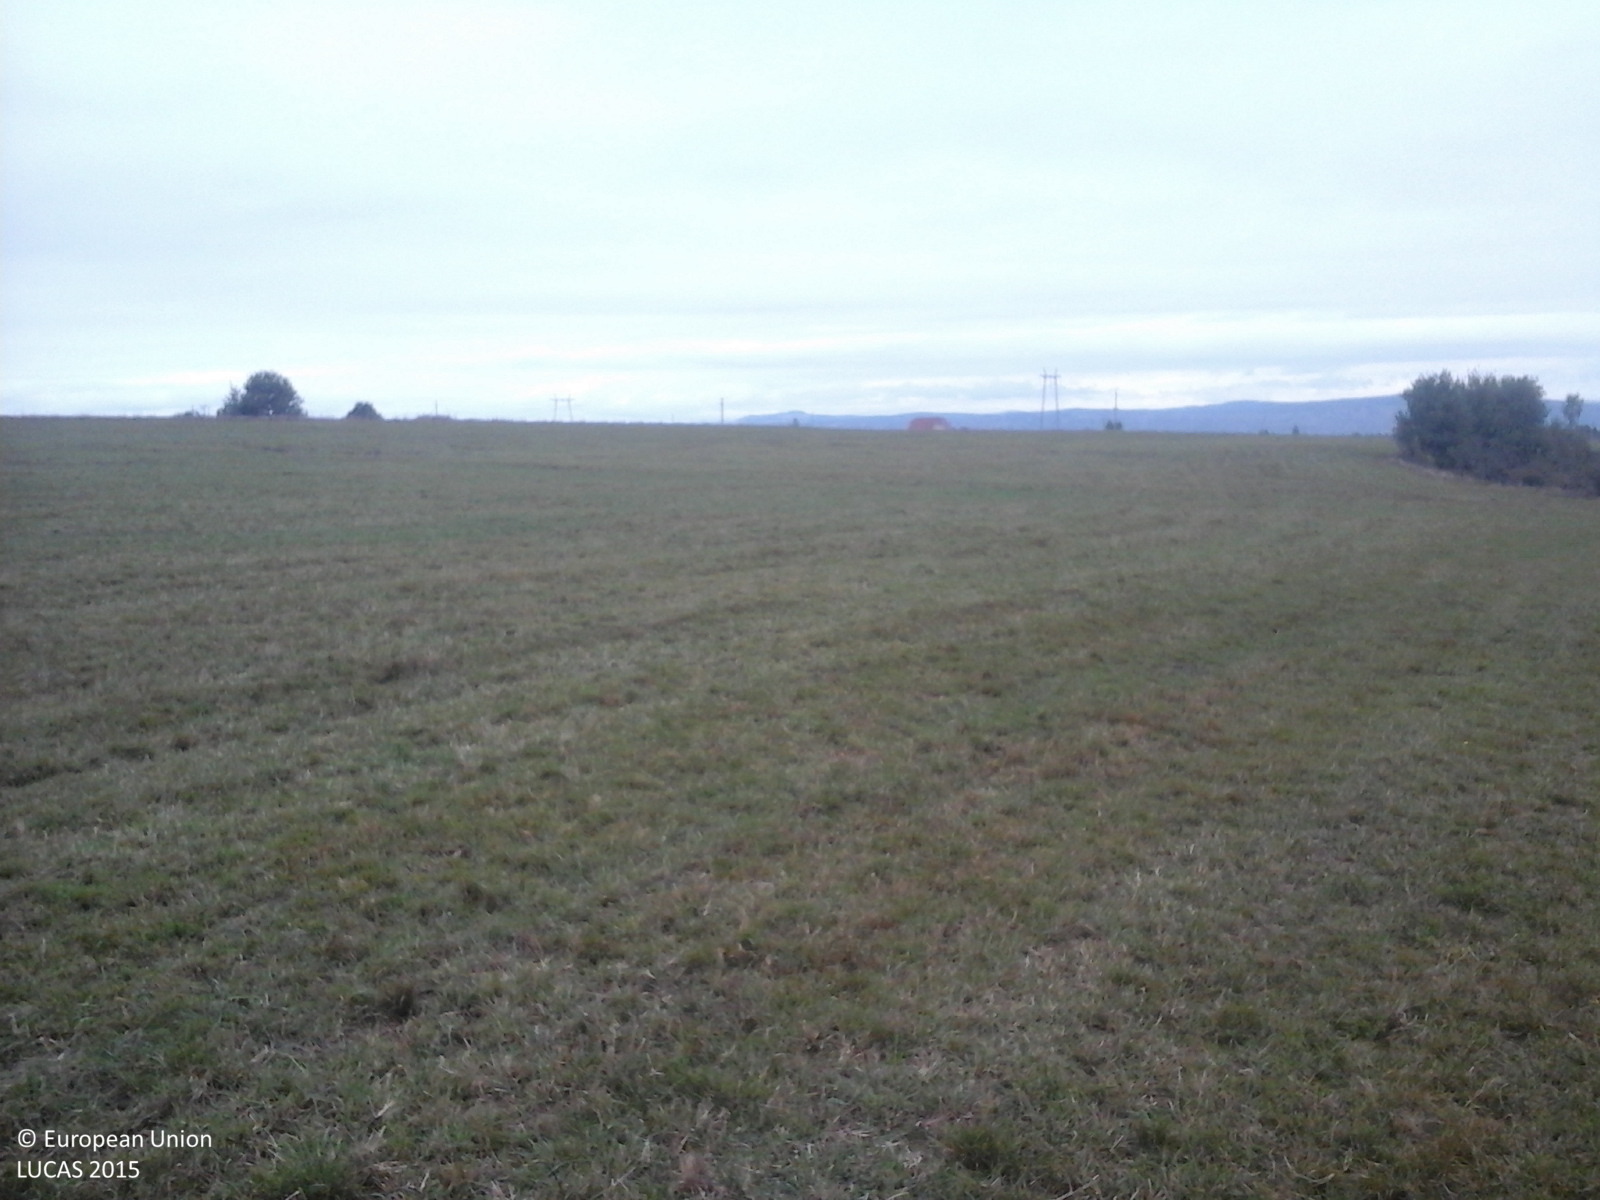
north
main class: Grassland
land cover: Grassland without tree/shrub cover
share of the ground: > 75 %
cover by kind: herbaceous plants 100 %
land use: Agriculture (excluding fallow land and kitchen gardens)
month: October
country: RO
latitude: 45.7282
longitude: 24.7215
